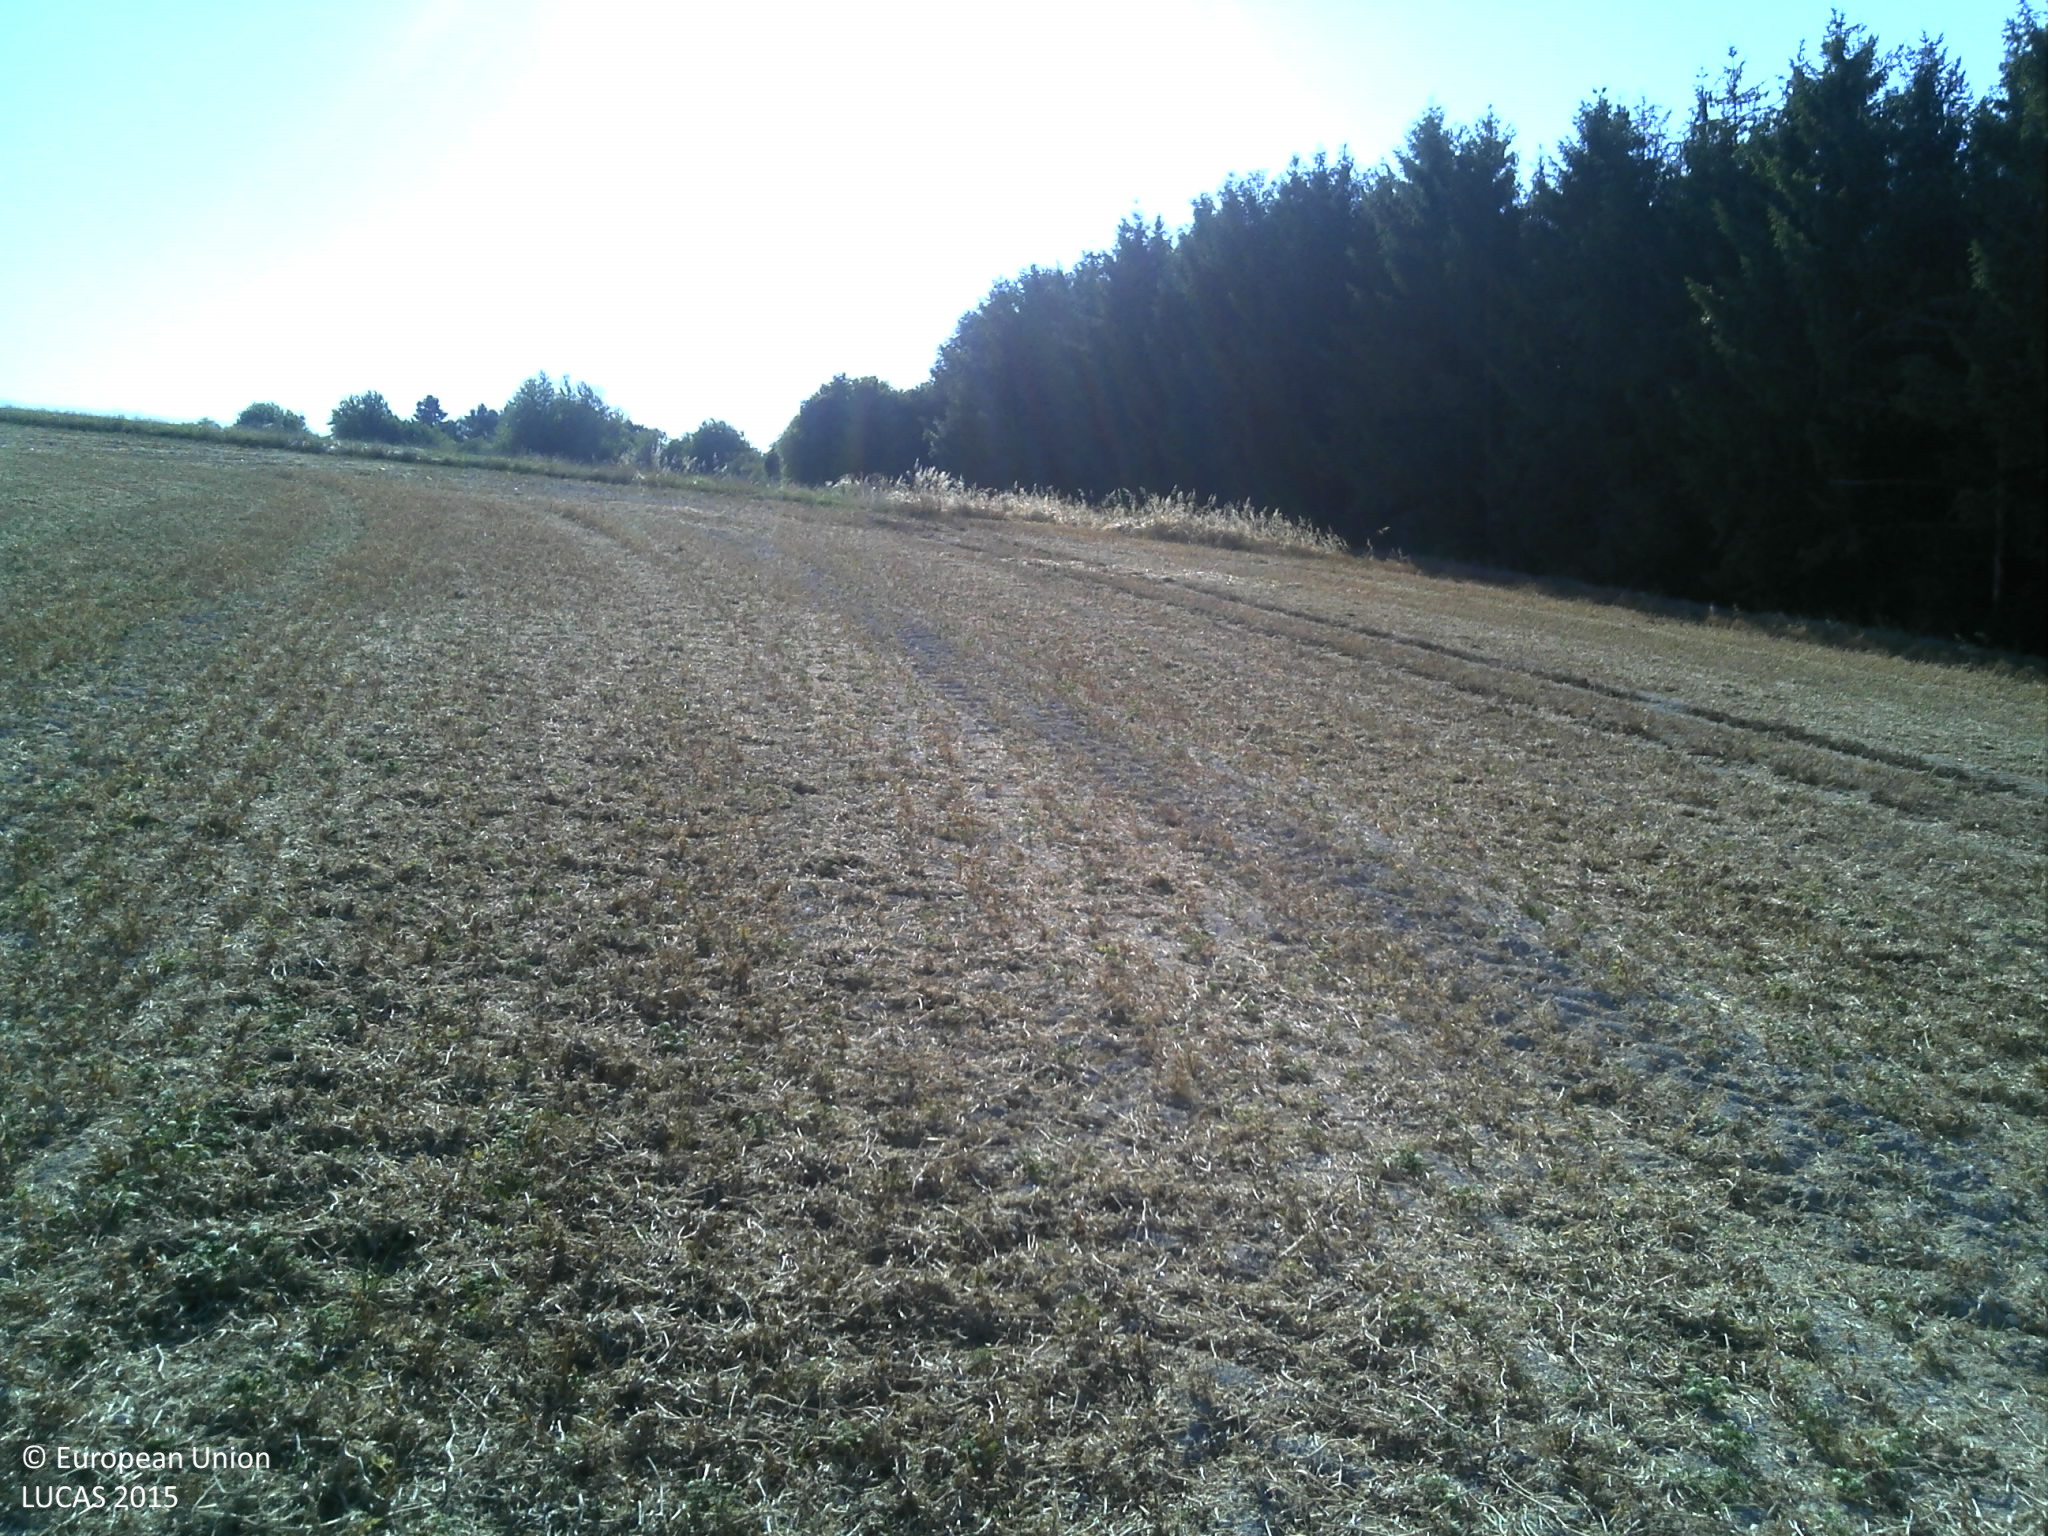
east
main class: Cropland
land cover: Dry pulses
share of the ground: > 75 %
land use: Agriculture (excluding fallow land and kitchen gardens)
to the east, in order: Dry pulses; Tracks; Lucerne; Broadleaved woodland
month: August
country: FR
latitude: 49.1261
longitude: 4.7487
